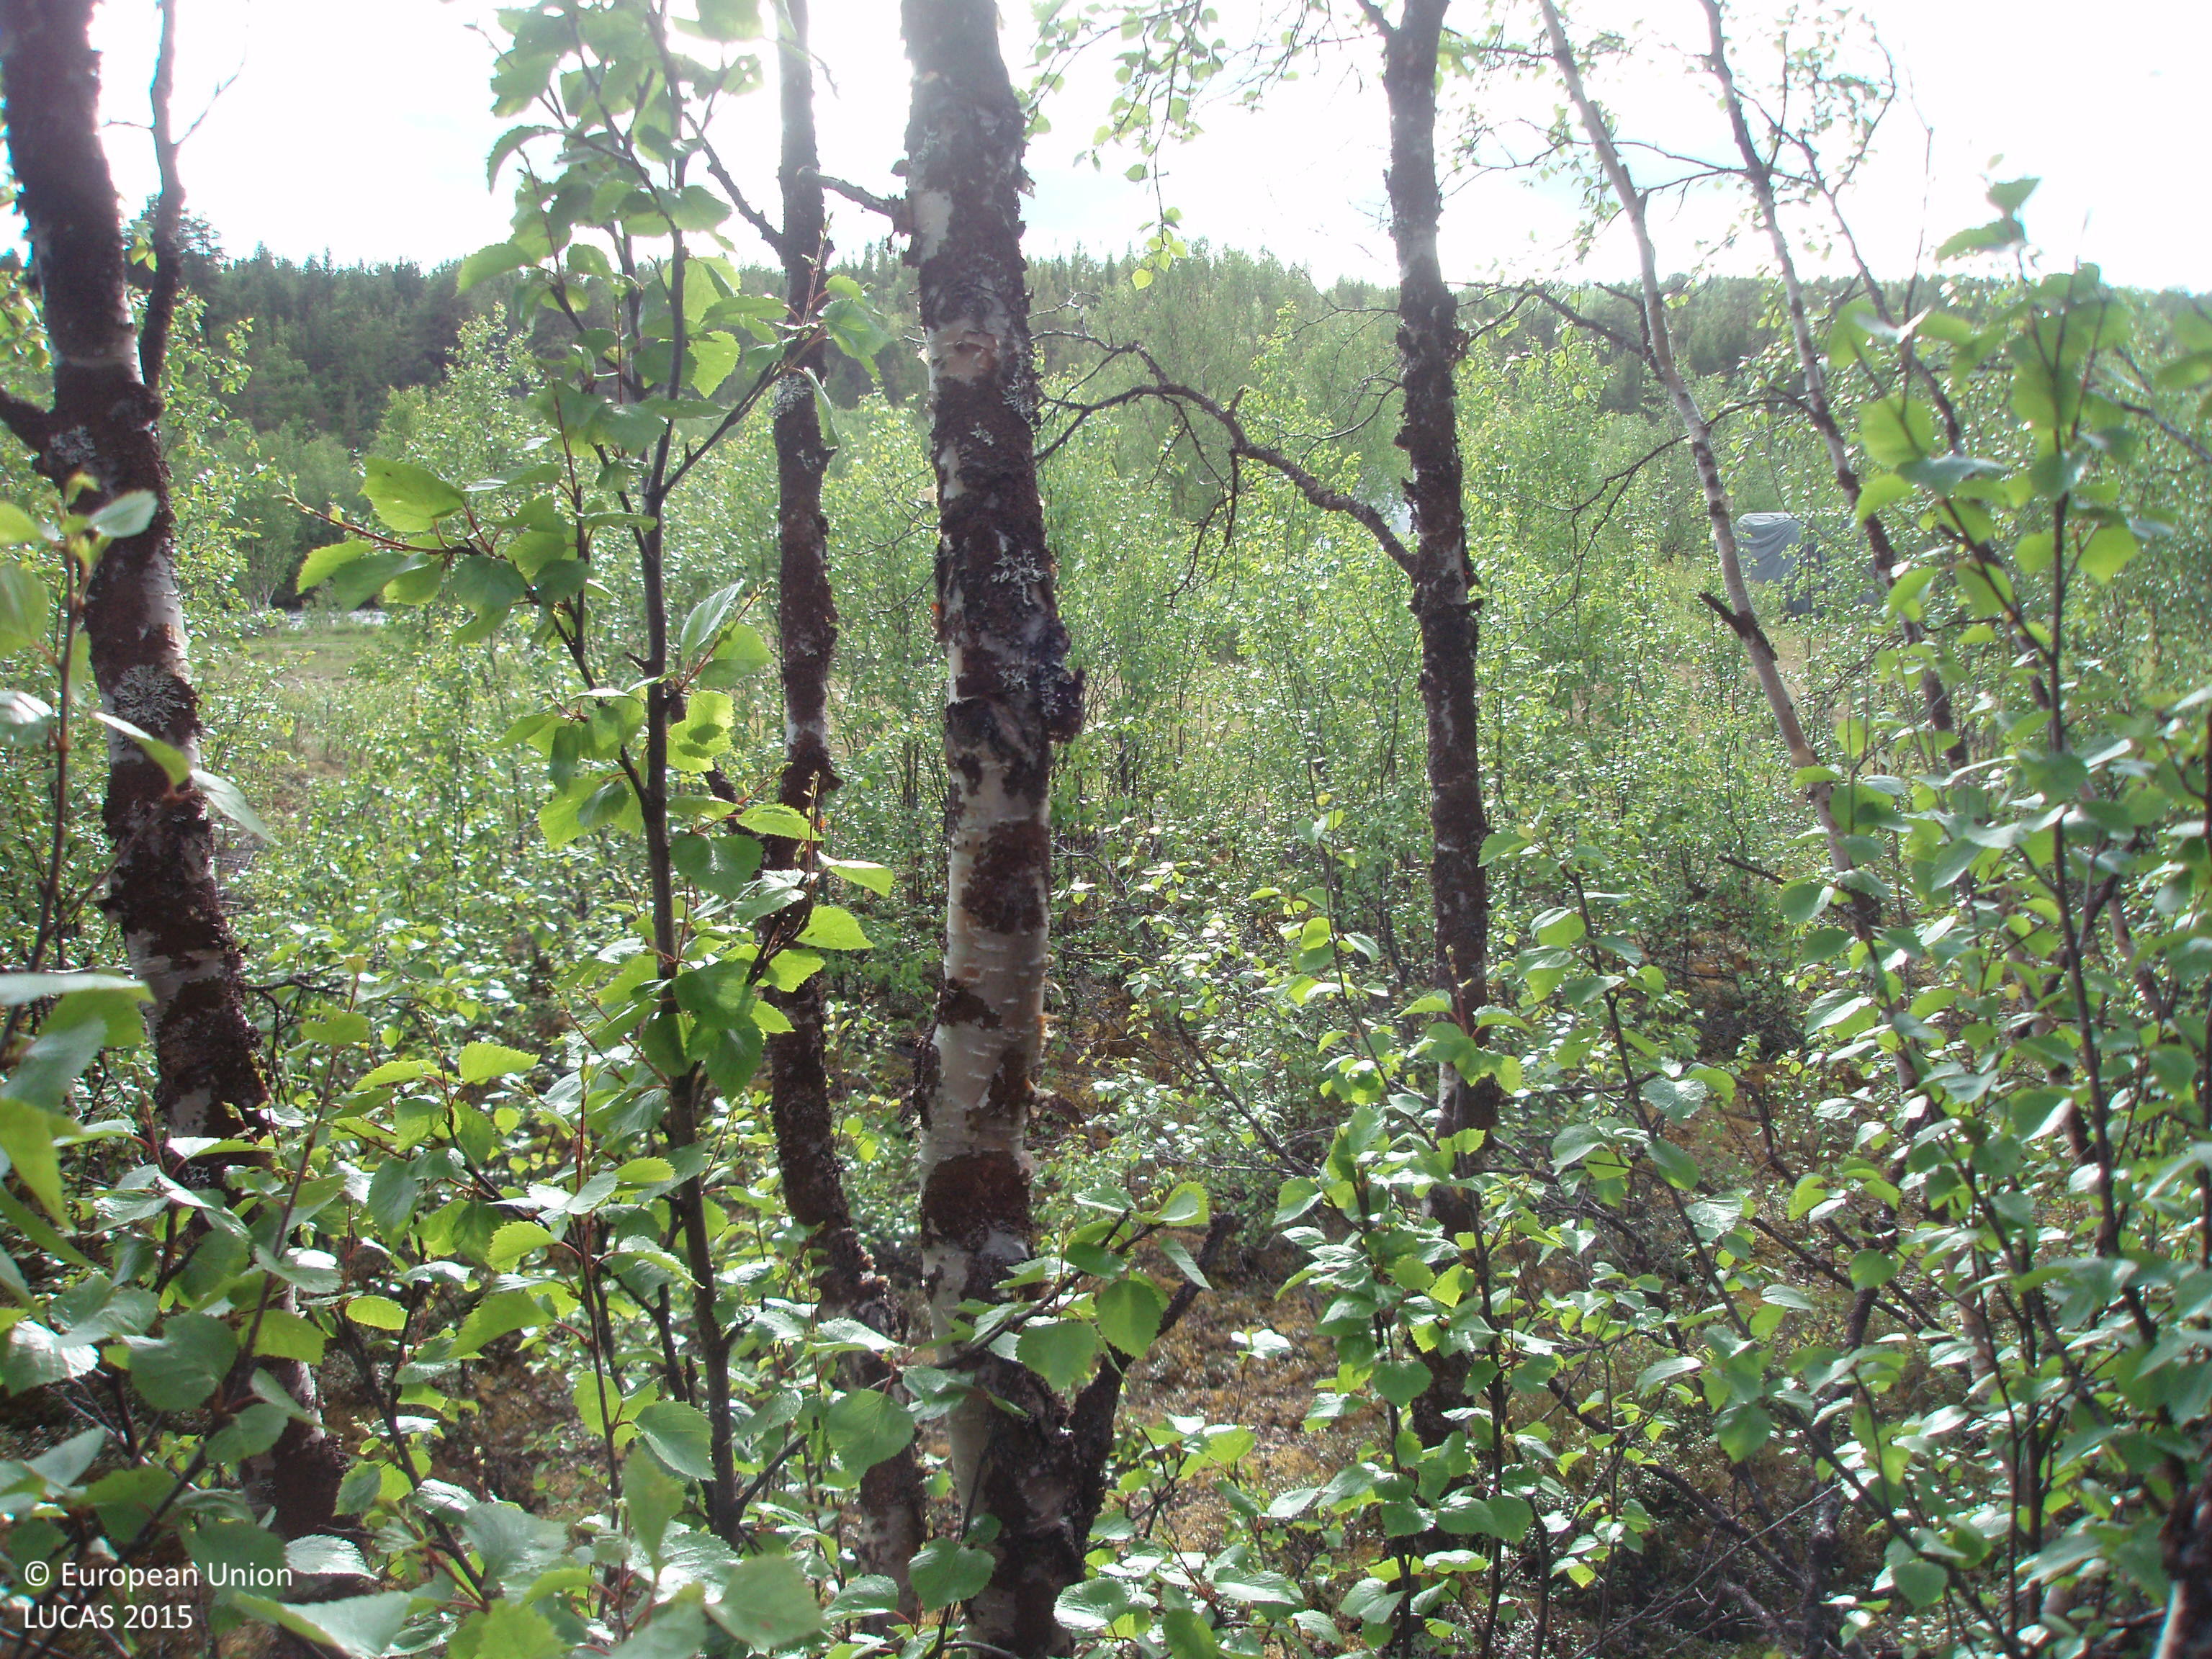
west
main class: Woodland
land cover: Pine dominated mixed woodland
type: boreal forest
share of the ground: > 75 %
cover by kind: broadleaved forest trees 60 %, coniferous forest trees 30 %, shrubs 10 %
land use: Forestry
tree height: > 5 m
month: July
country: FI
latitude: 69.0612
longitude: 25.7497
